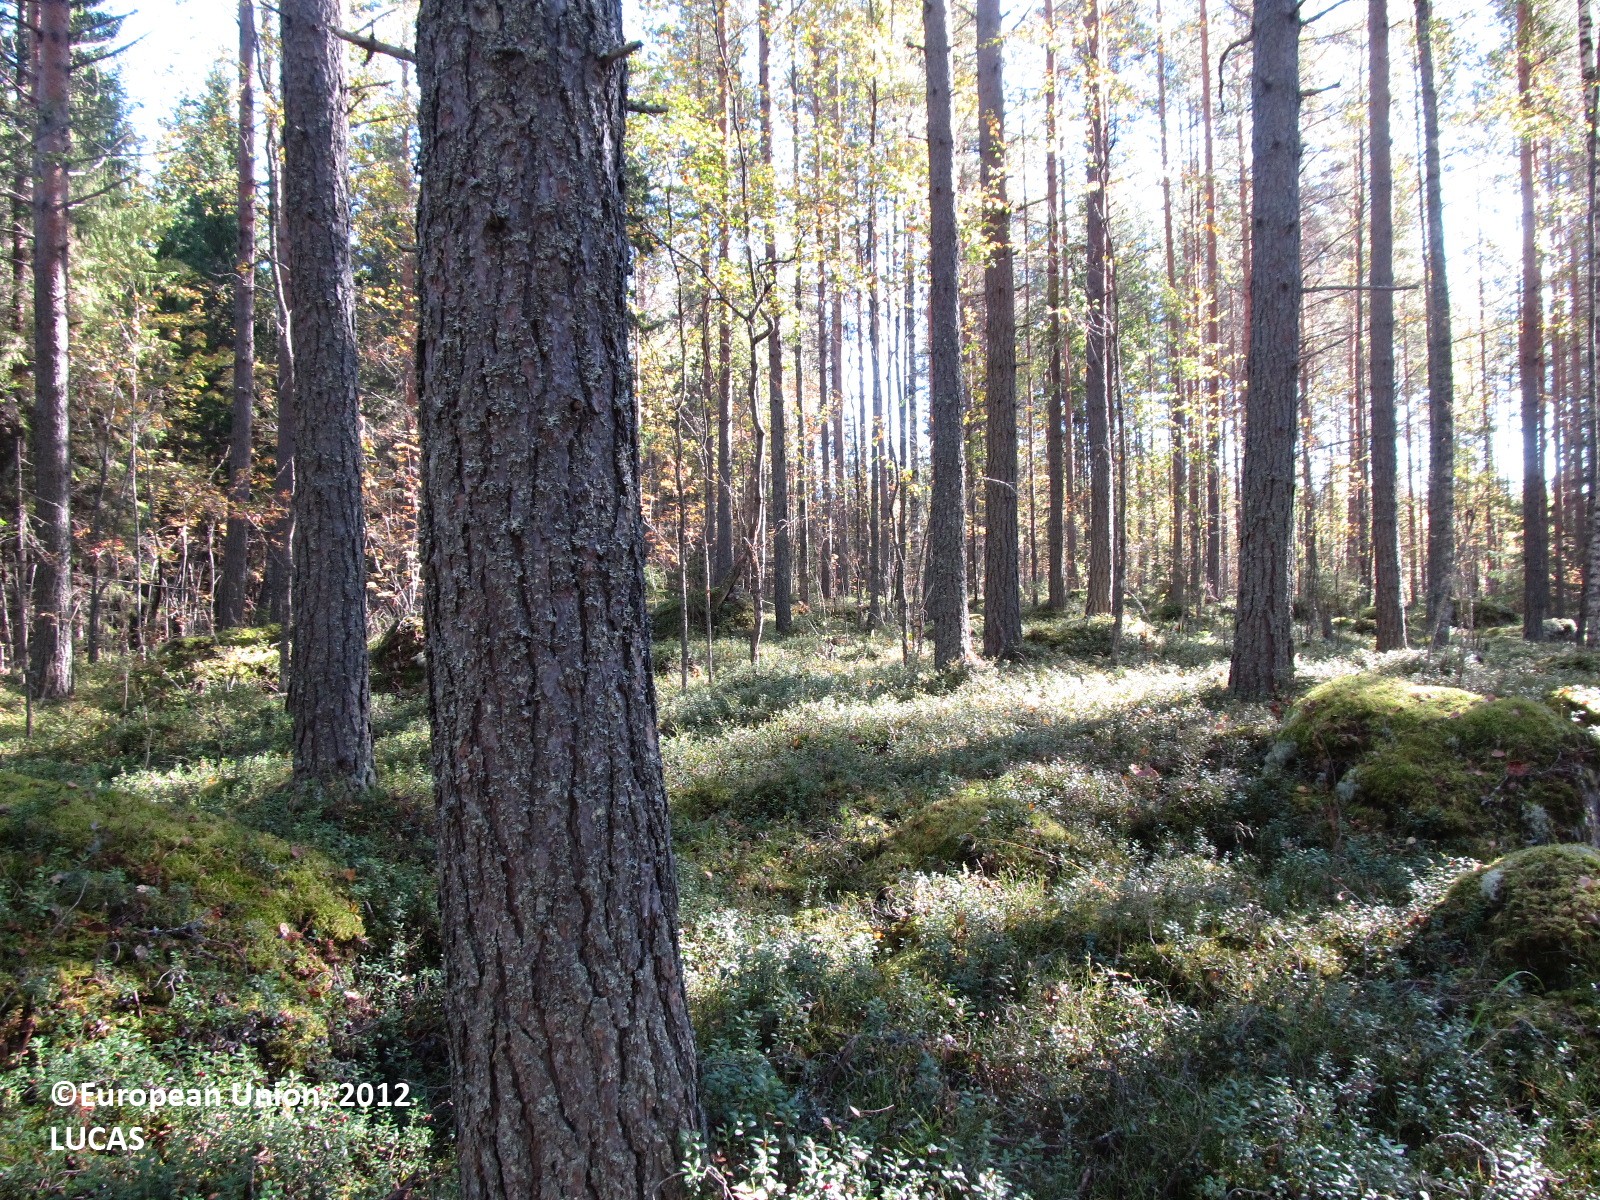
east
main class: Woodland
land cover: Pine dominated coniferous woodland
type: boreal forest
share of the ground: 25 - 50 %
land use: Forestry
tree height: > 5 m
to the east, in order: Pine dominated coniferous woodland; Spruce dominated coniferous woodland; Broadleaved woodland; Rape and turnip rape
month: September
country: FI
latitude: 62.4897
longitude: 28.2194
